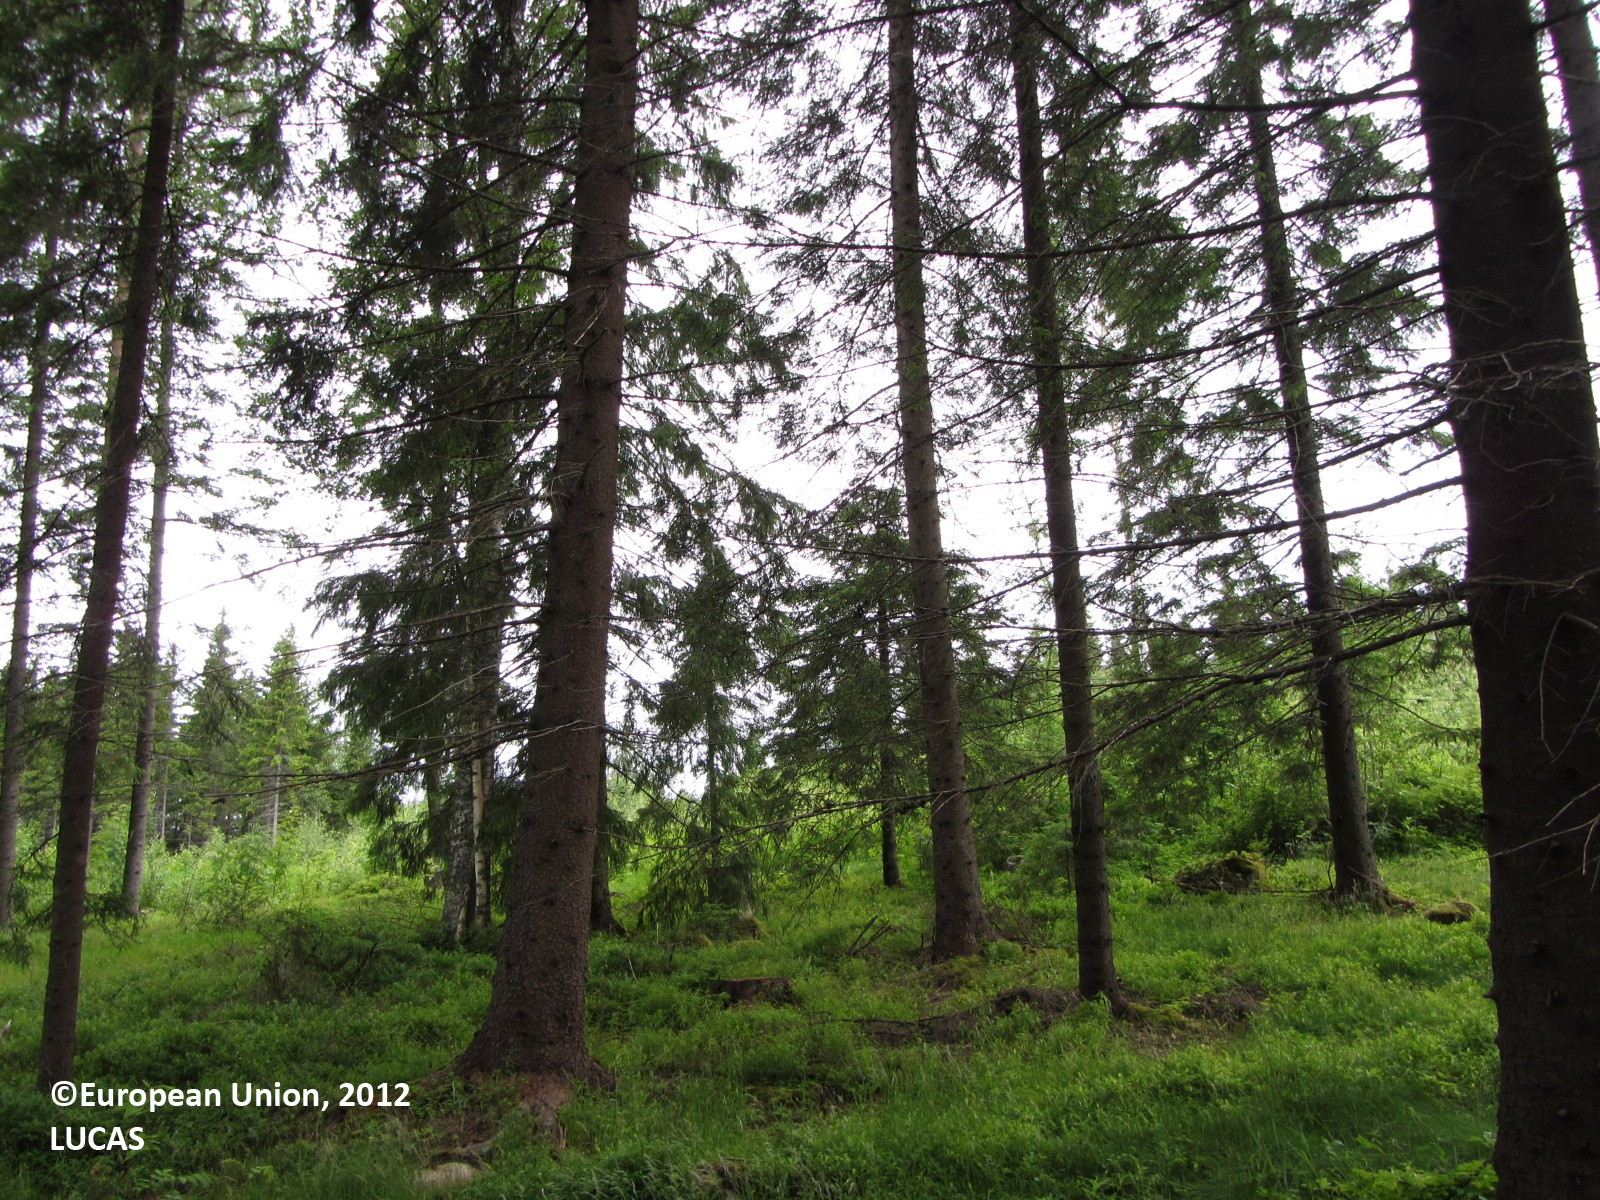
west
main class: Woodland
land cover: Spruce dominated mixed woodland
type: boreal forest
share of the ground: 50 - 75 %
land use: Forestry
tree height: > 5 m
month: June
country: FI
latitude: 62.5940
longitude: 25.5150
